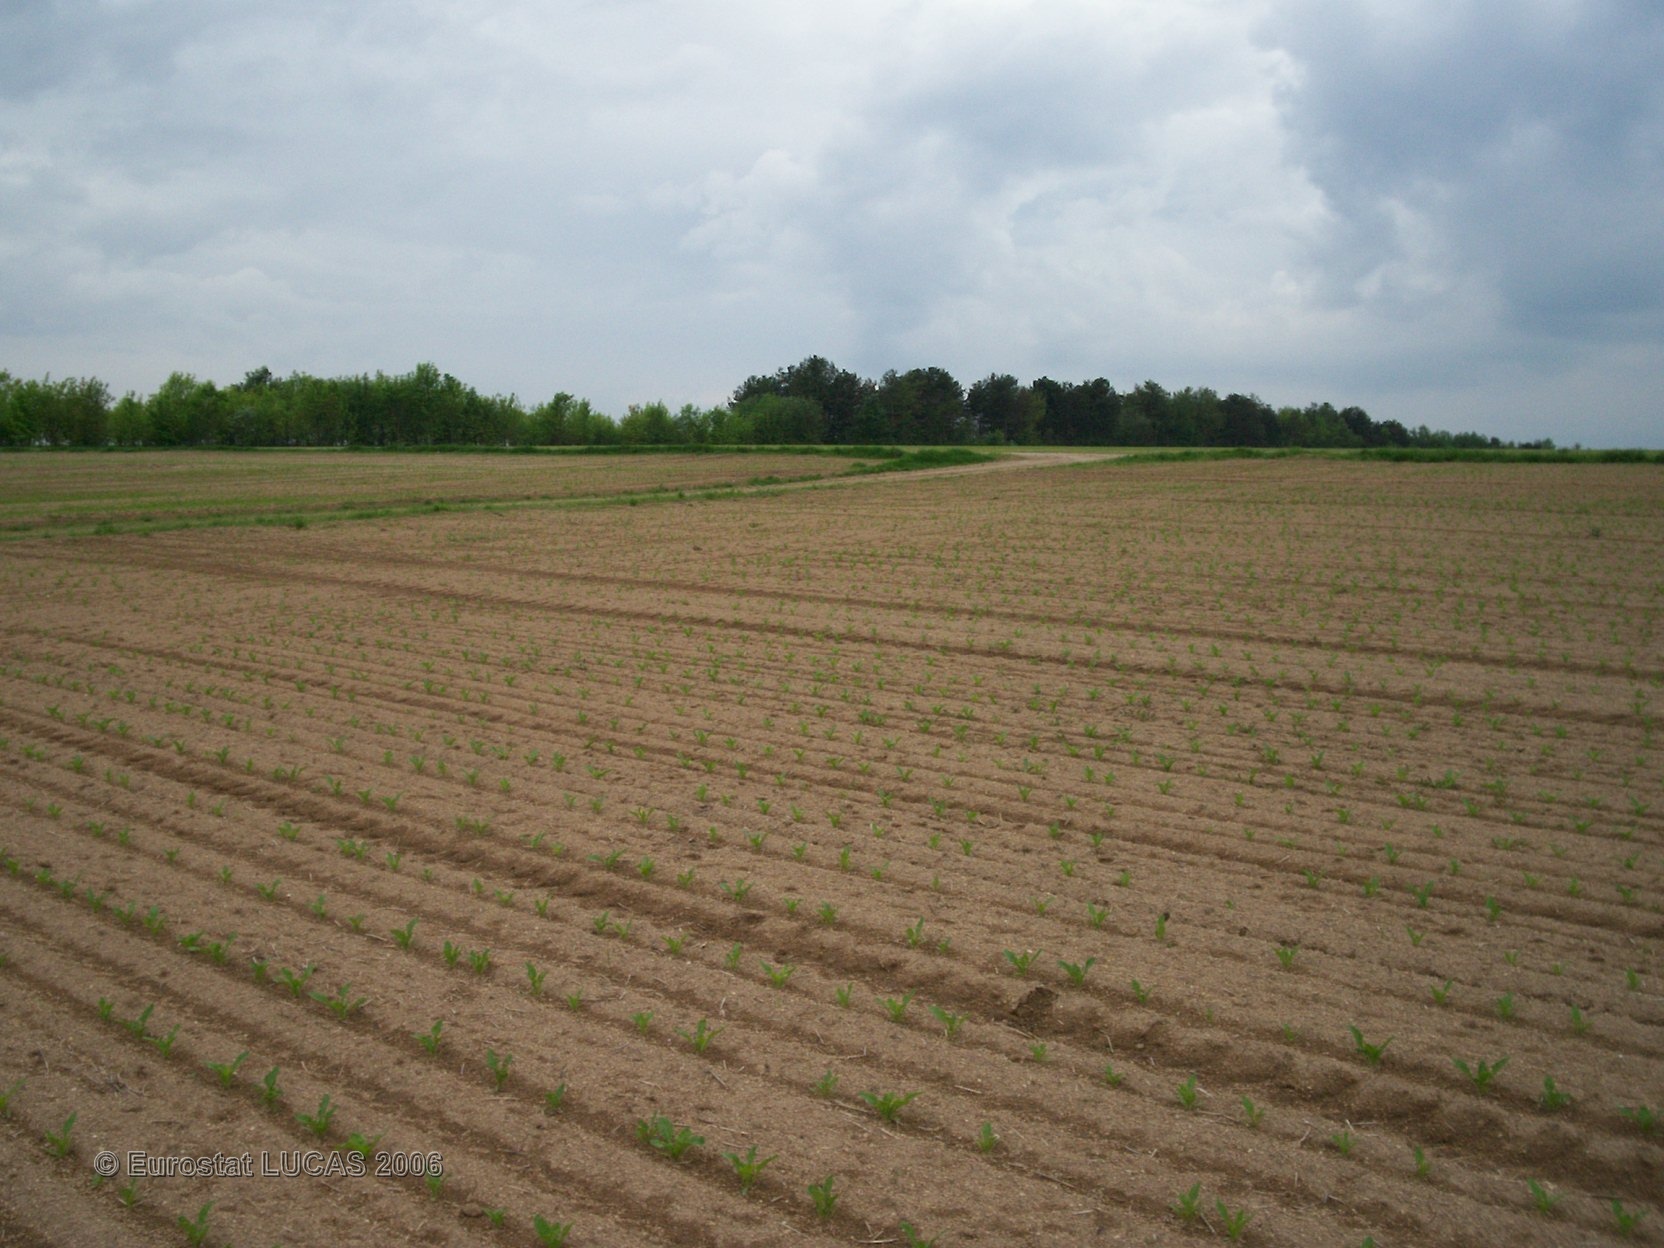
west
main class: Cropland
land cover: Sugar beet
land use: Agriculture (excluding fallow land and kitchen gardens)
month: May
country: FR
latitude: 49.2688
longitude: 4.3475
